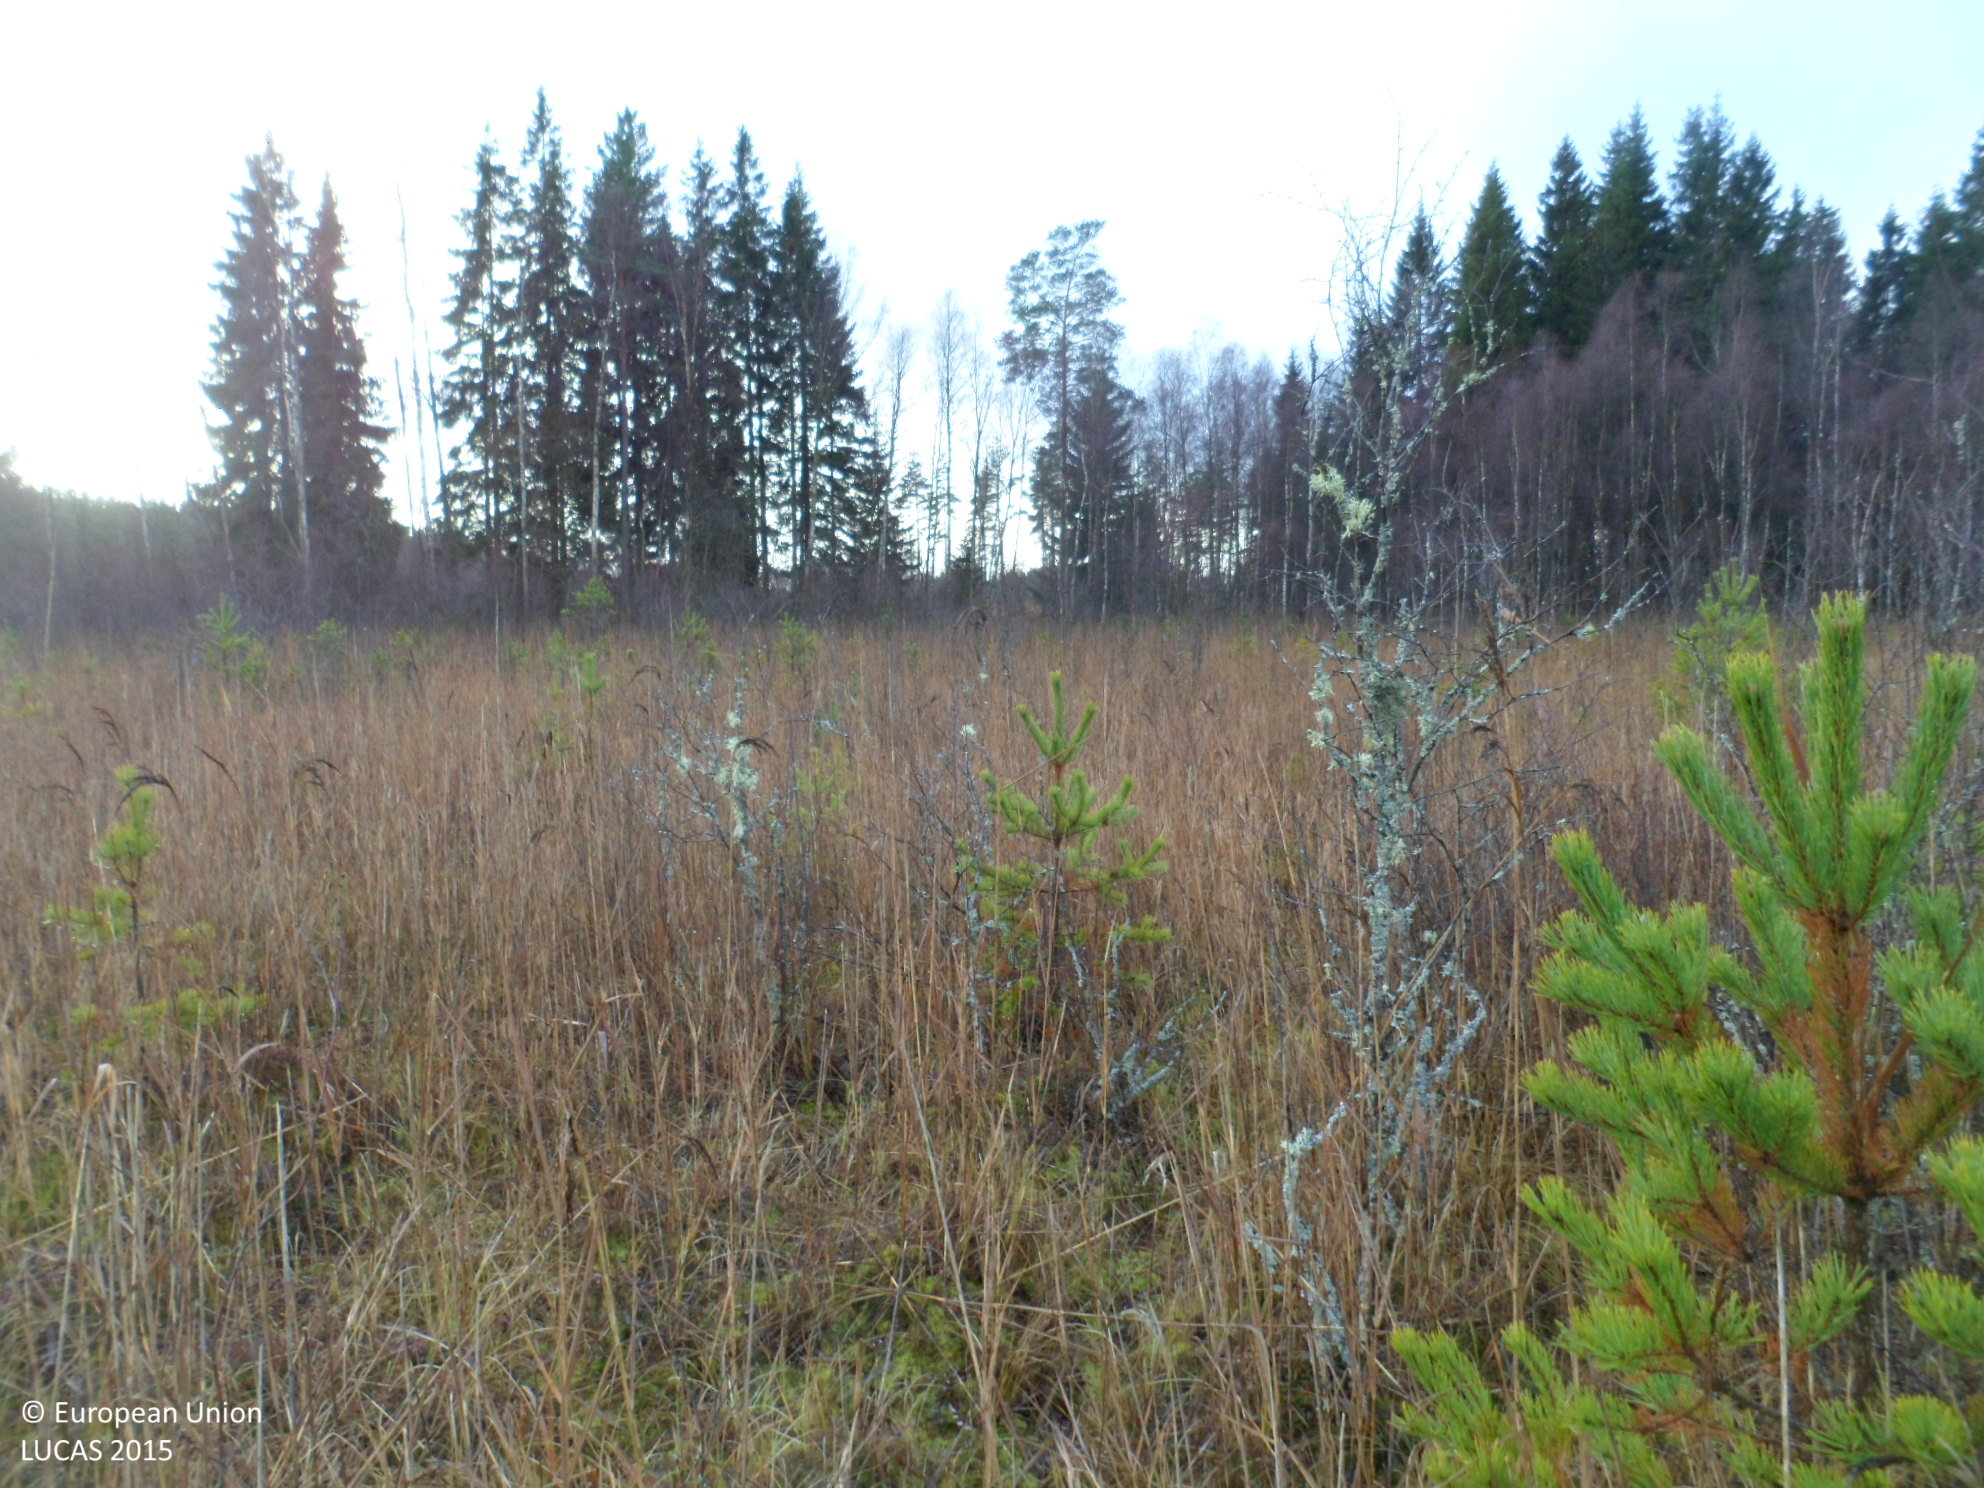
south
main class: Woodland
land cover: Pine dominated mixed woodland
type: mire and swamp forests
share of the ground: 10 - 25 %
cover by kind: lichens and mosses 40 %, herbaceous plants 30 %, coniferous forest trees 10 %, broadleaved forest trees 10 %, shrubs 10 %
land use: Semi-natural and natural areas not in use
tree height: < 5 m
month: November
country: SE
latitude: 57.5625
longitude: 15.9986
